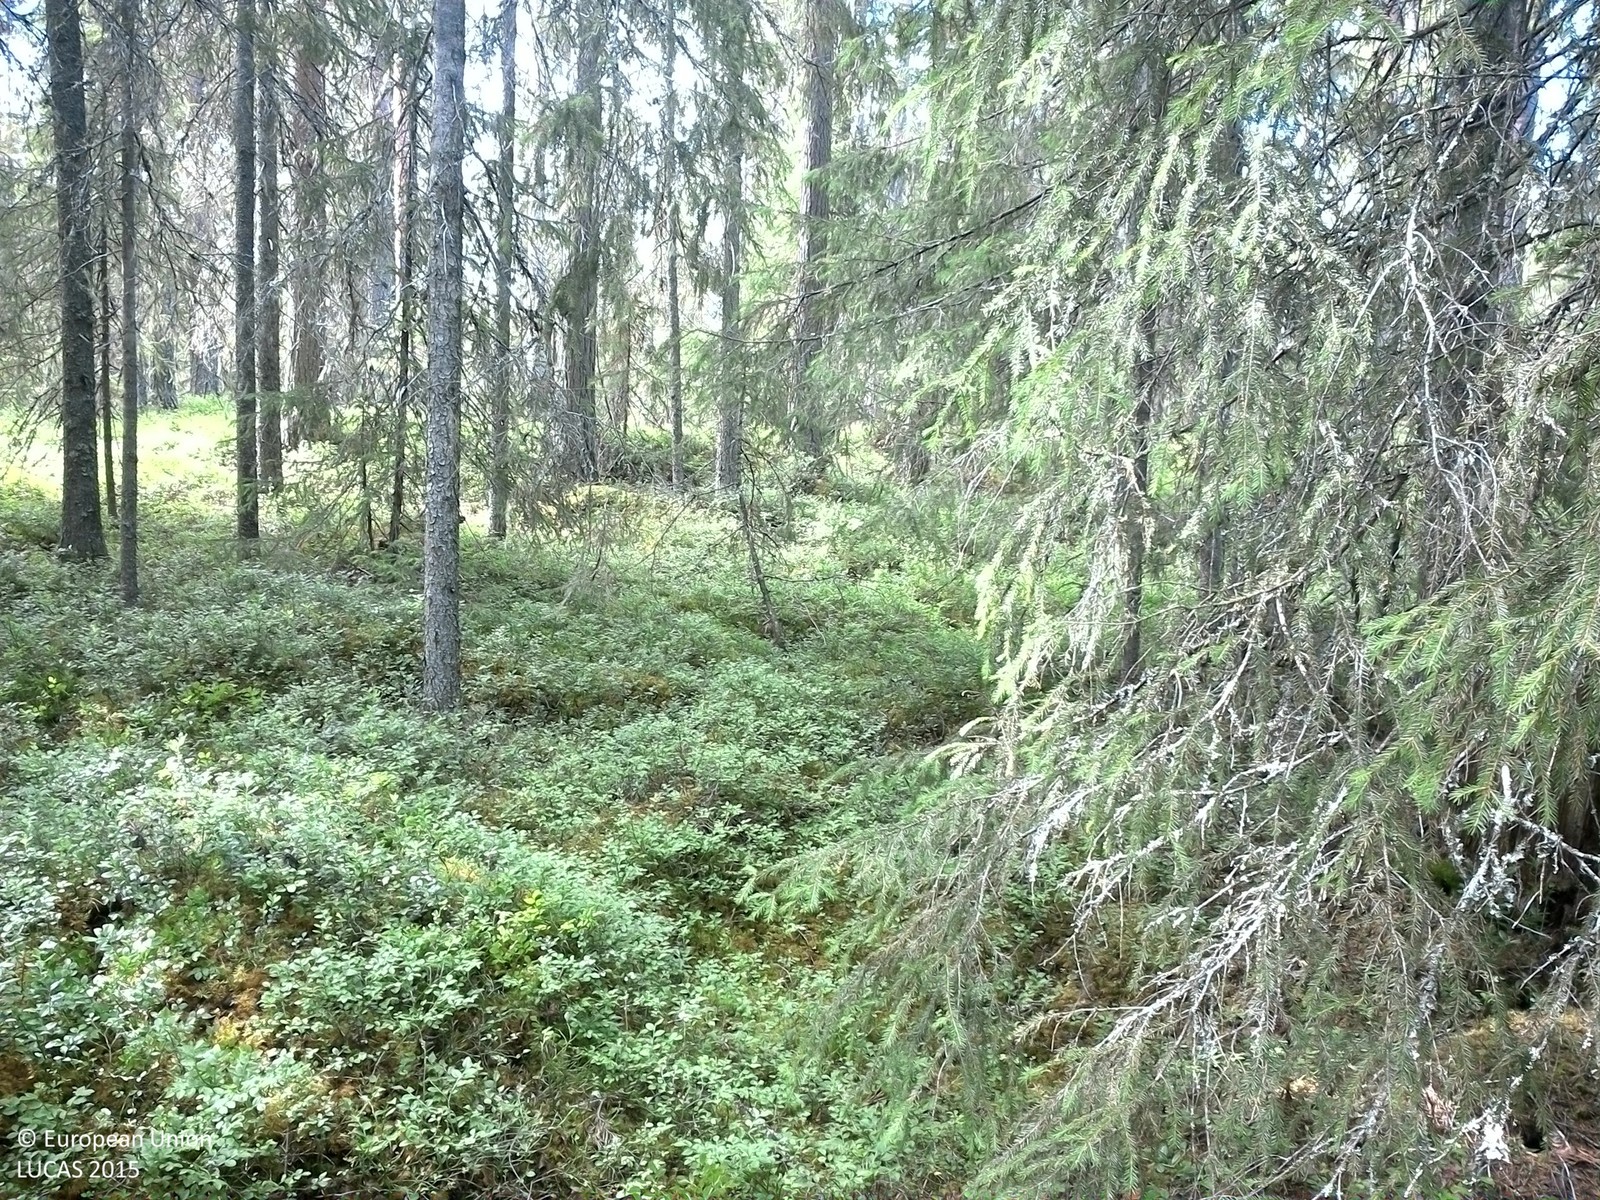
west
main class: Woodland
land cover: Spruce dominated coniferous woodland
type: boreal forest
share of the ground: 50 - 75 %
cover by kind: coniferous forest trees 60 %, shrubs 25 %, lichens and mosses 10 %, broadleaved forest trees 5 %
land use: Forestry
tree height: > 5 m
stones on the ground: < 10 %
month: August
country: SE
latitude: 63.7483
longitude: 16.7201
